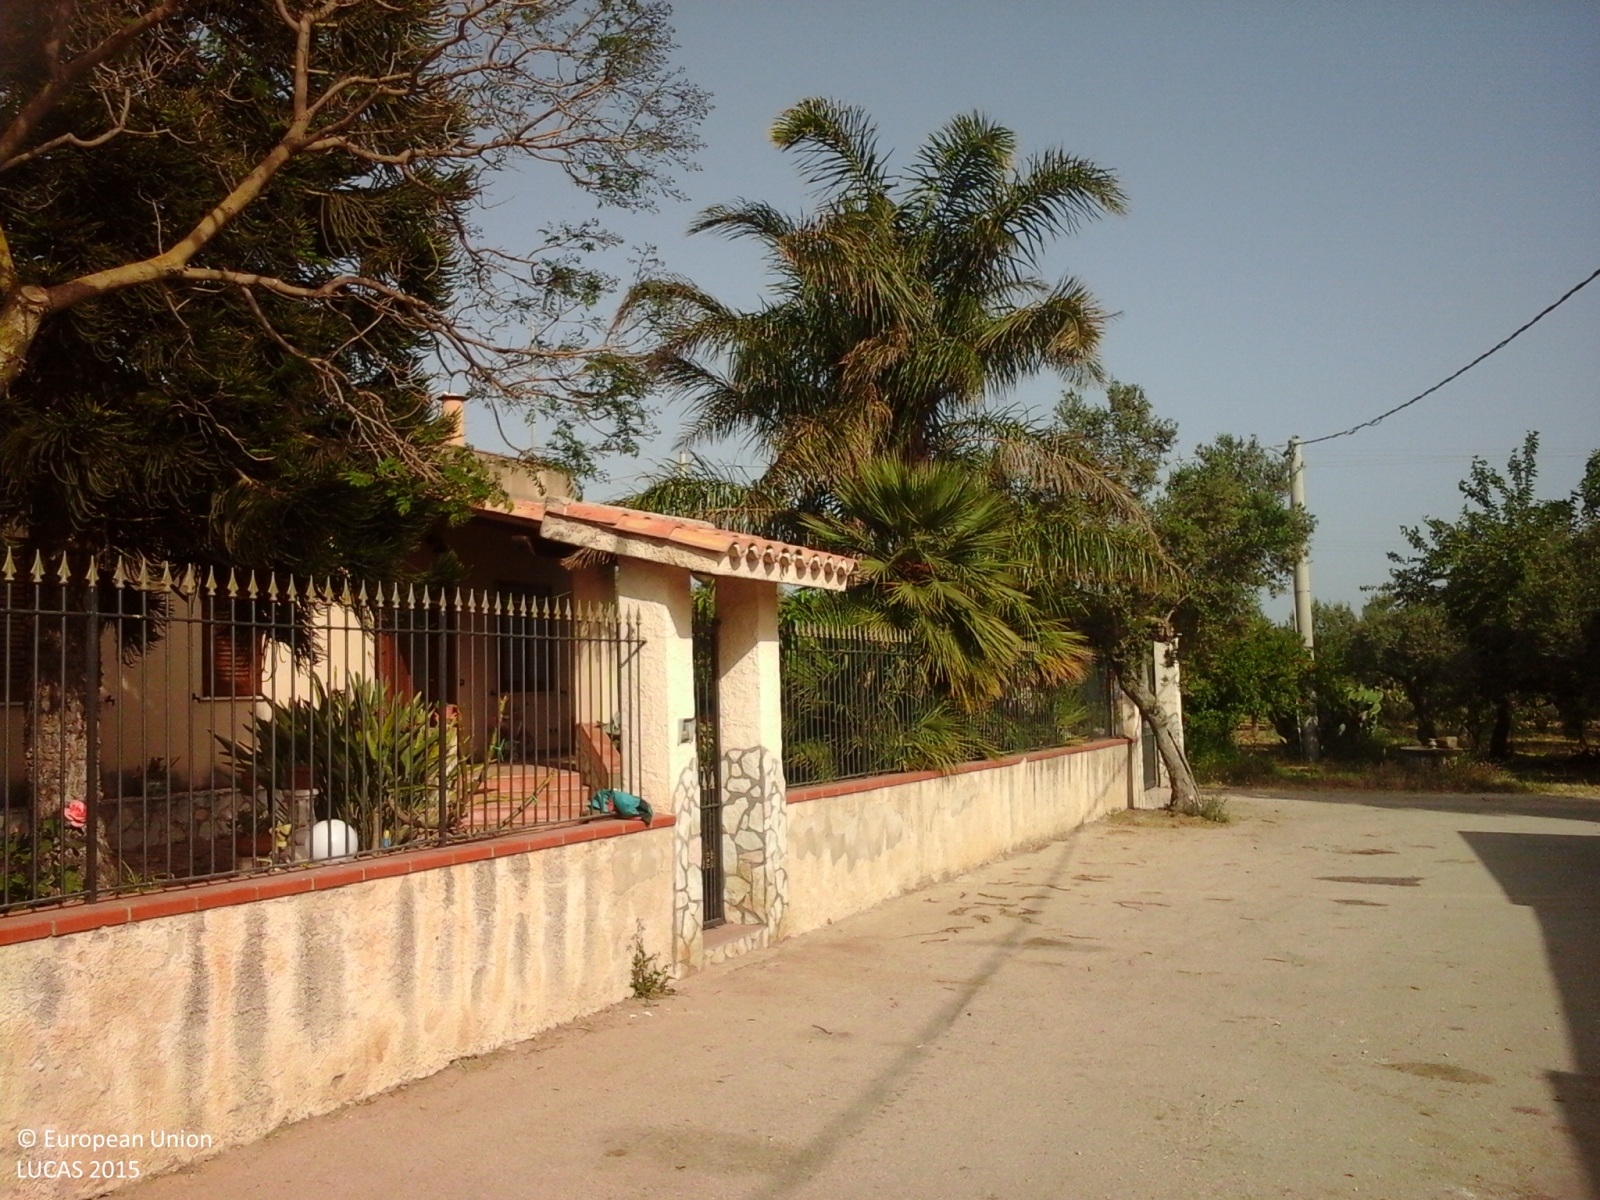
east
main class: Cropland
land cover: Olive groves
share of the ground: 50 - 75 %
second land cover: Other bare soil
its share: > 75 %
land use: Agriculture (excluding fallow land and kitchen gardens)
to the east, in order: Olive groves; Other bare soil; Artificial constructions in urban areas; Olive groves; Tracks; Olive groves; Grassland with sparse tree/shrub cover; Olive groves
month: May
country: IT
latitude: 37.5535
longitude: 13.0443
